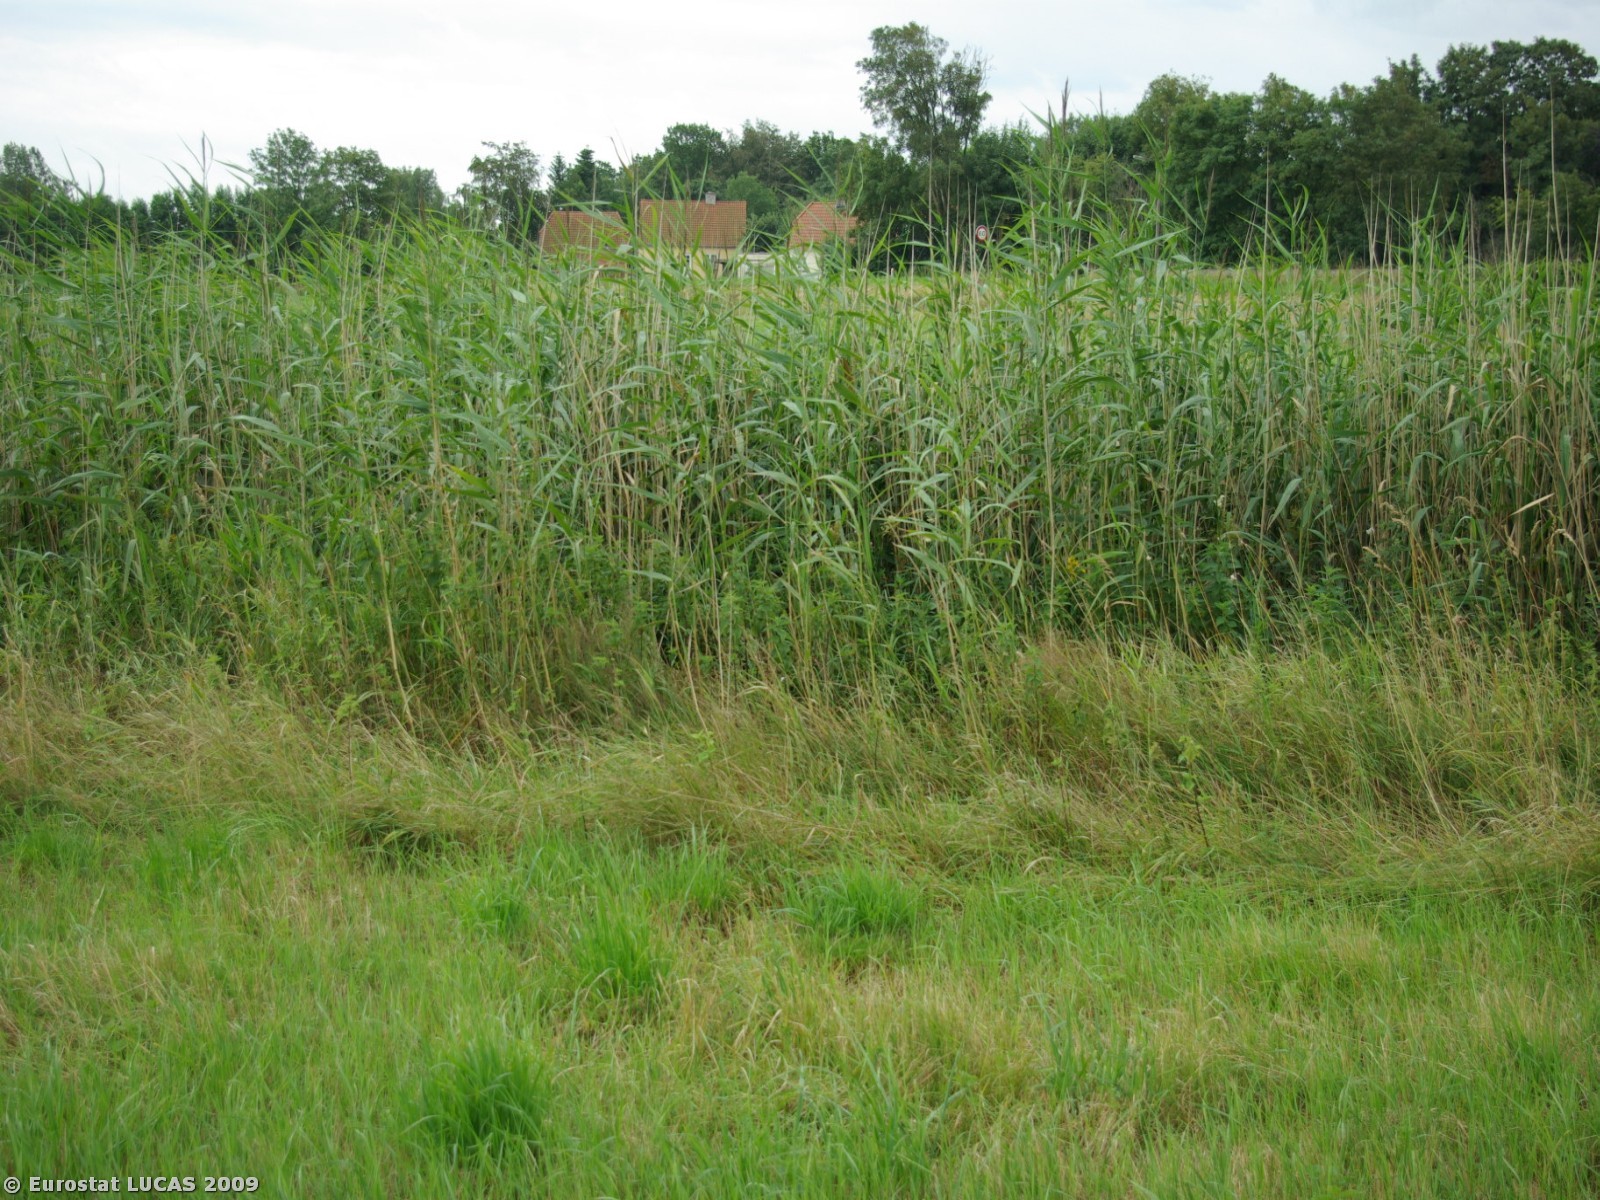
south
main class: Grassland
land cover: Grassland without tree/shrub cover
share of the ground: > 75 %
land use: Agriculture (excluding fallow land and kitchen gardens)
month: July
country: DK
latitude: 55.1927
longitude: 8.7286
